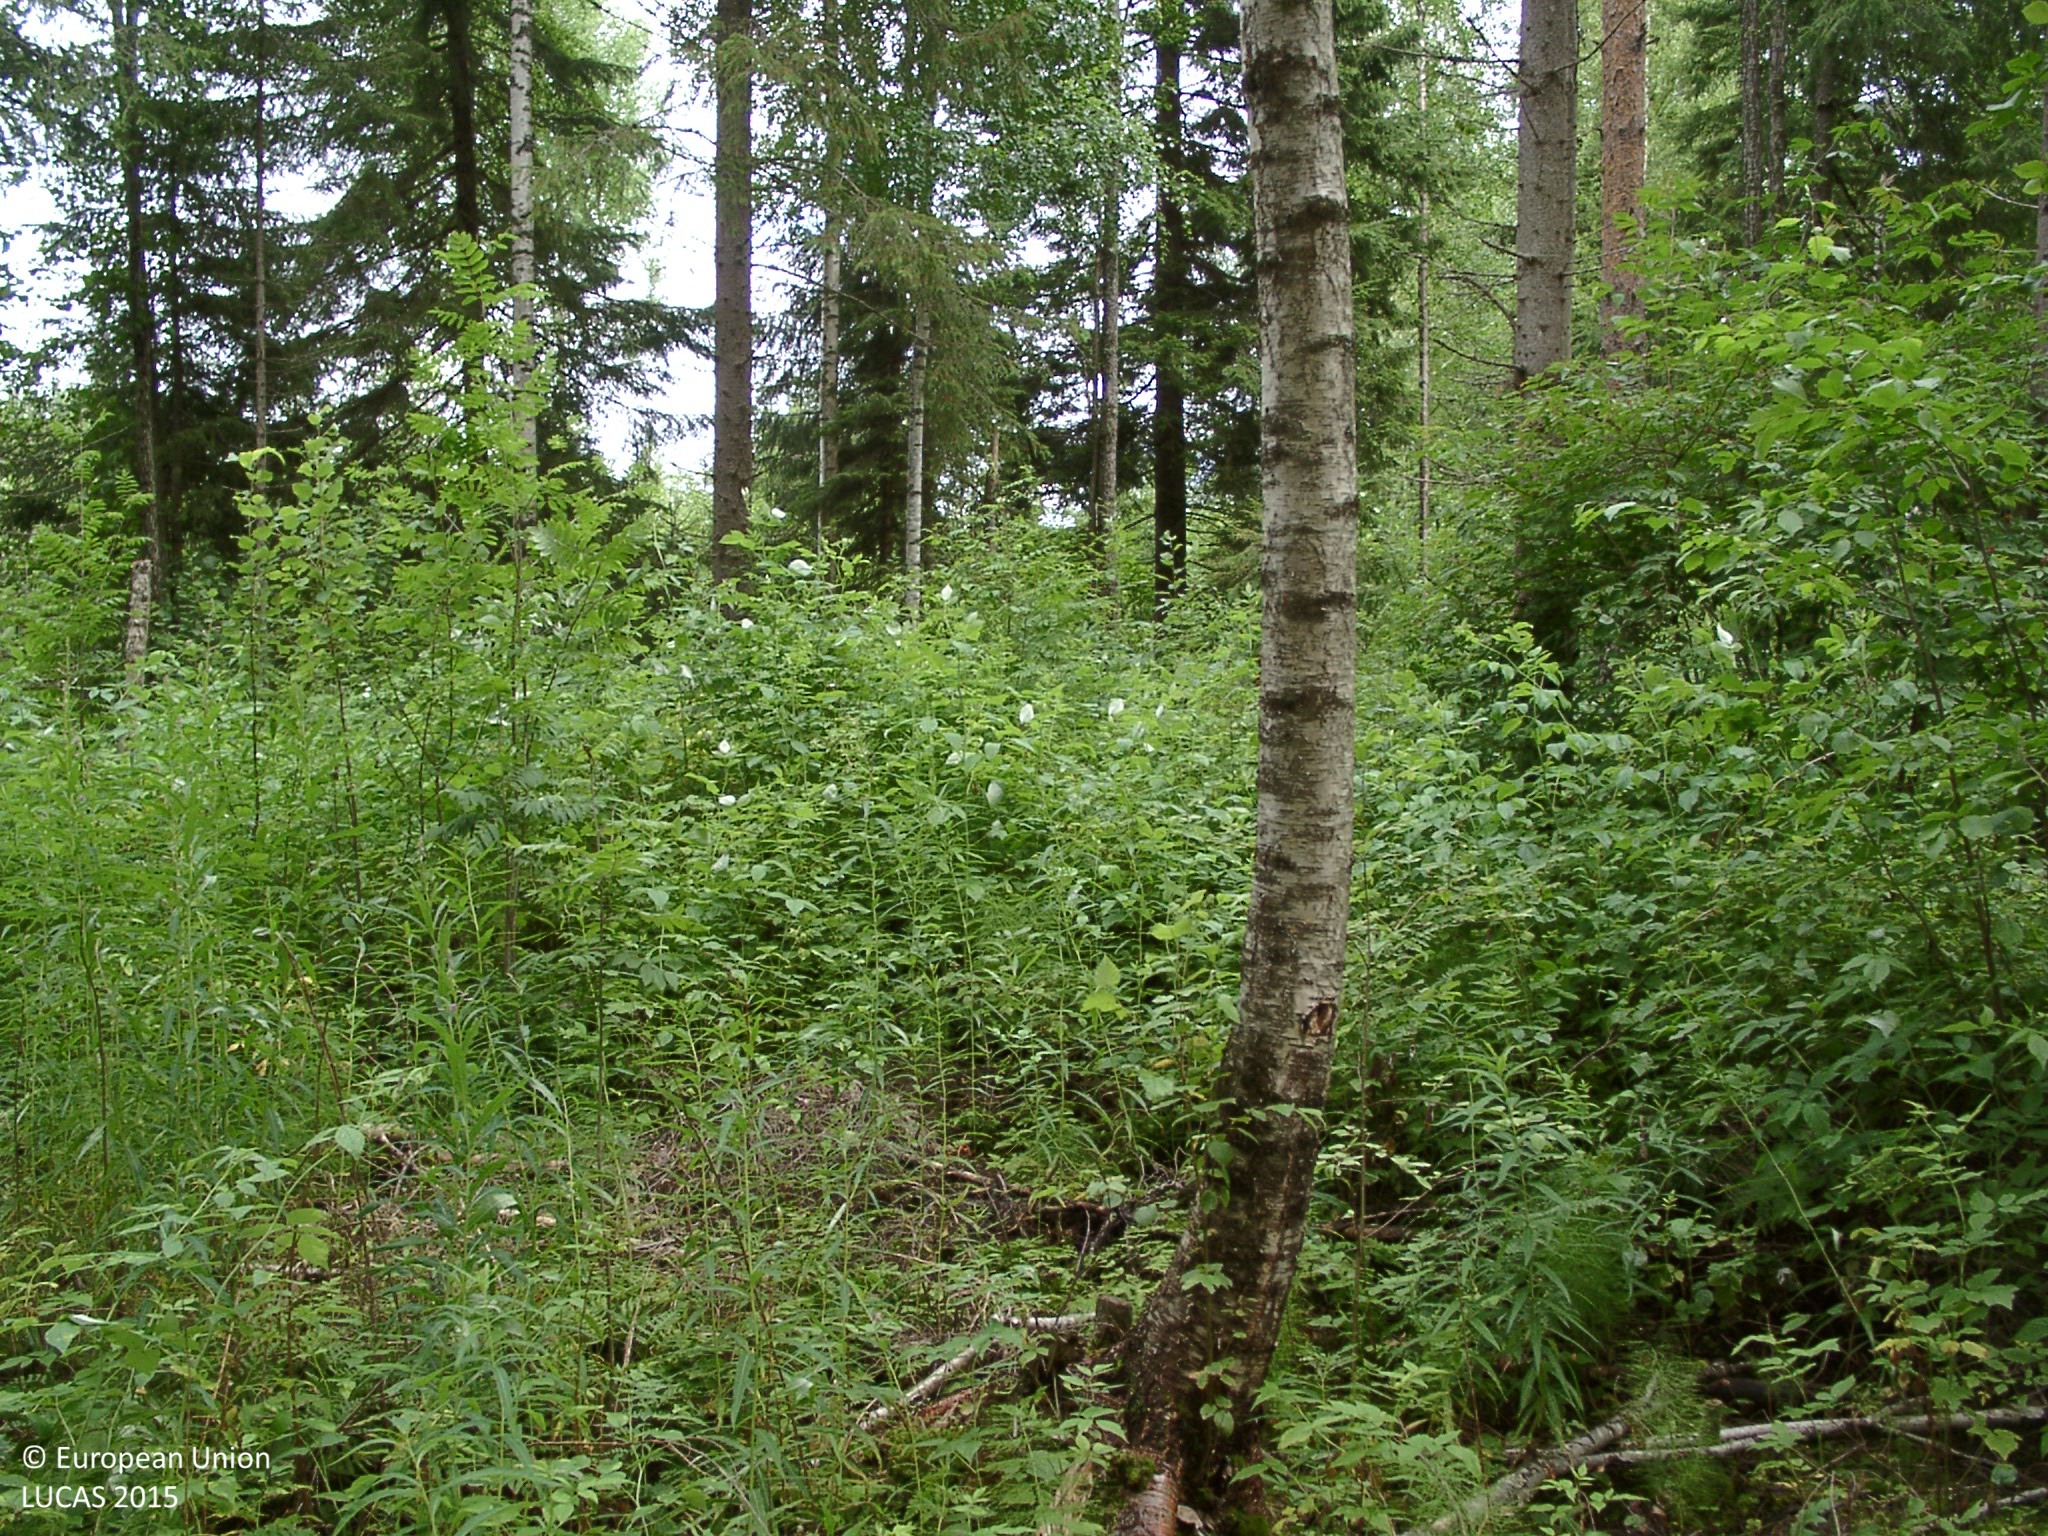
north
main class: Woodland
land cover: Spruce dominated mixed woodland
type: boreal forest
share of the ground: 50 - 75 %
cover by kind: coniferous forest trees 35 %, broadleaved forest trees 35 %, shrubs 15 %, herbaceous plants 15 %
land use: Forestry
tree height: > 5 m
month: July
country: FI
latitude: 62.2594
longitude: 26.0541
